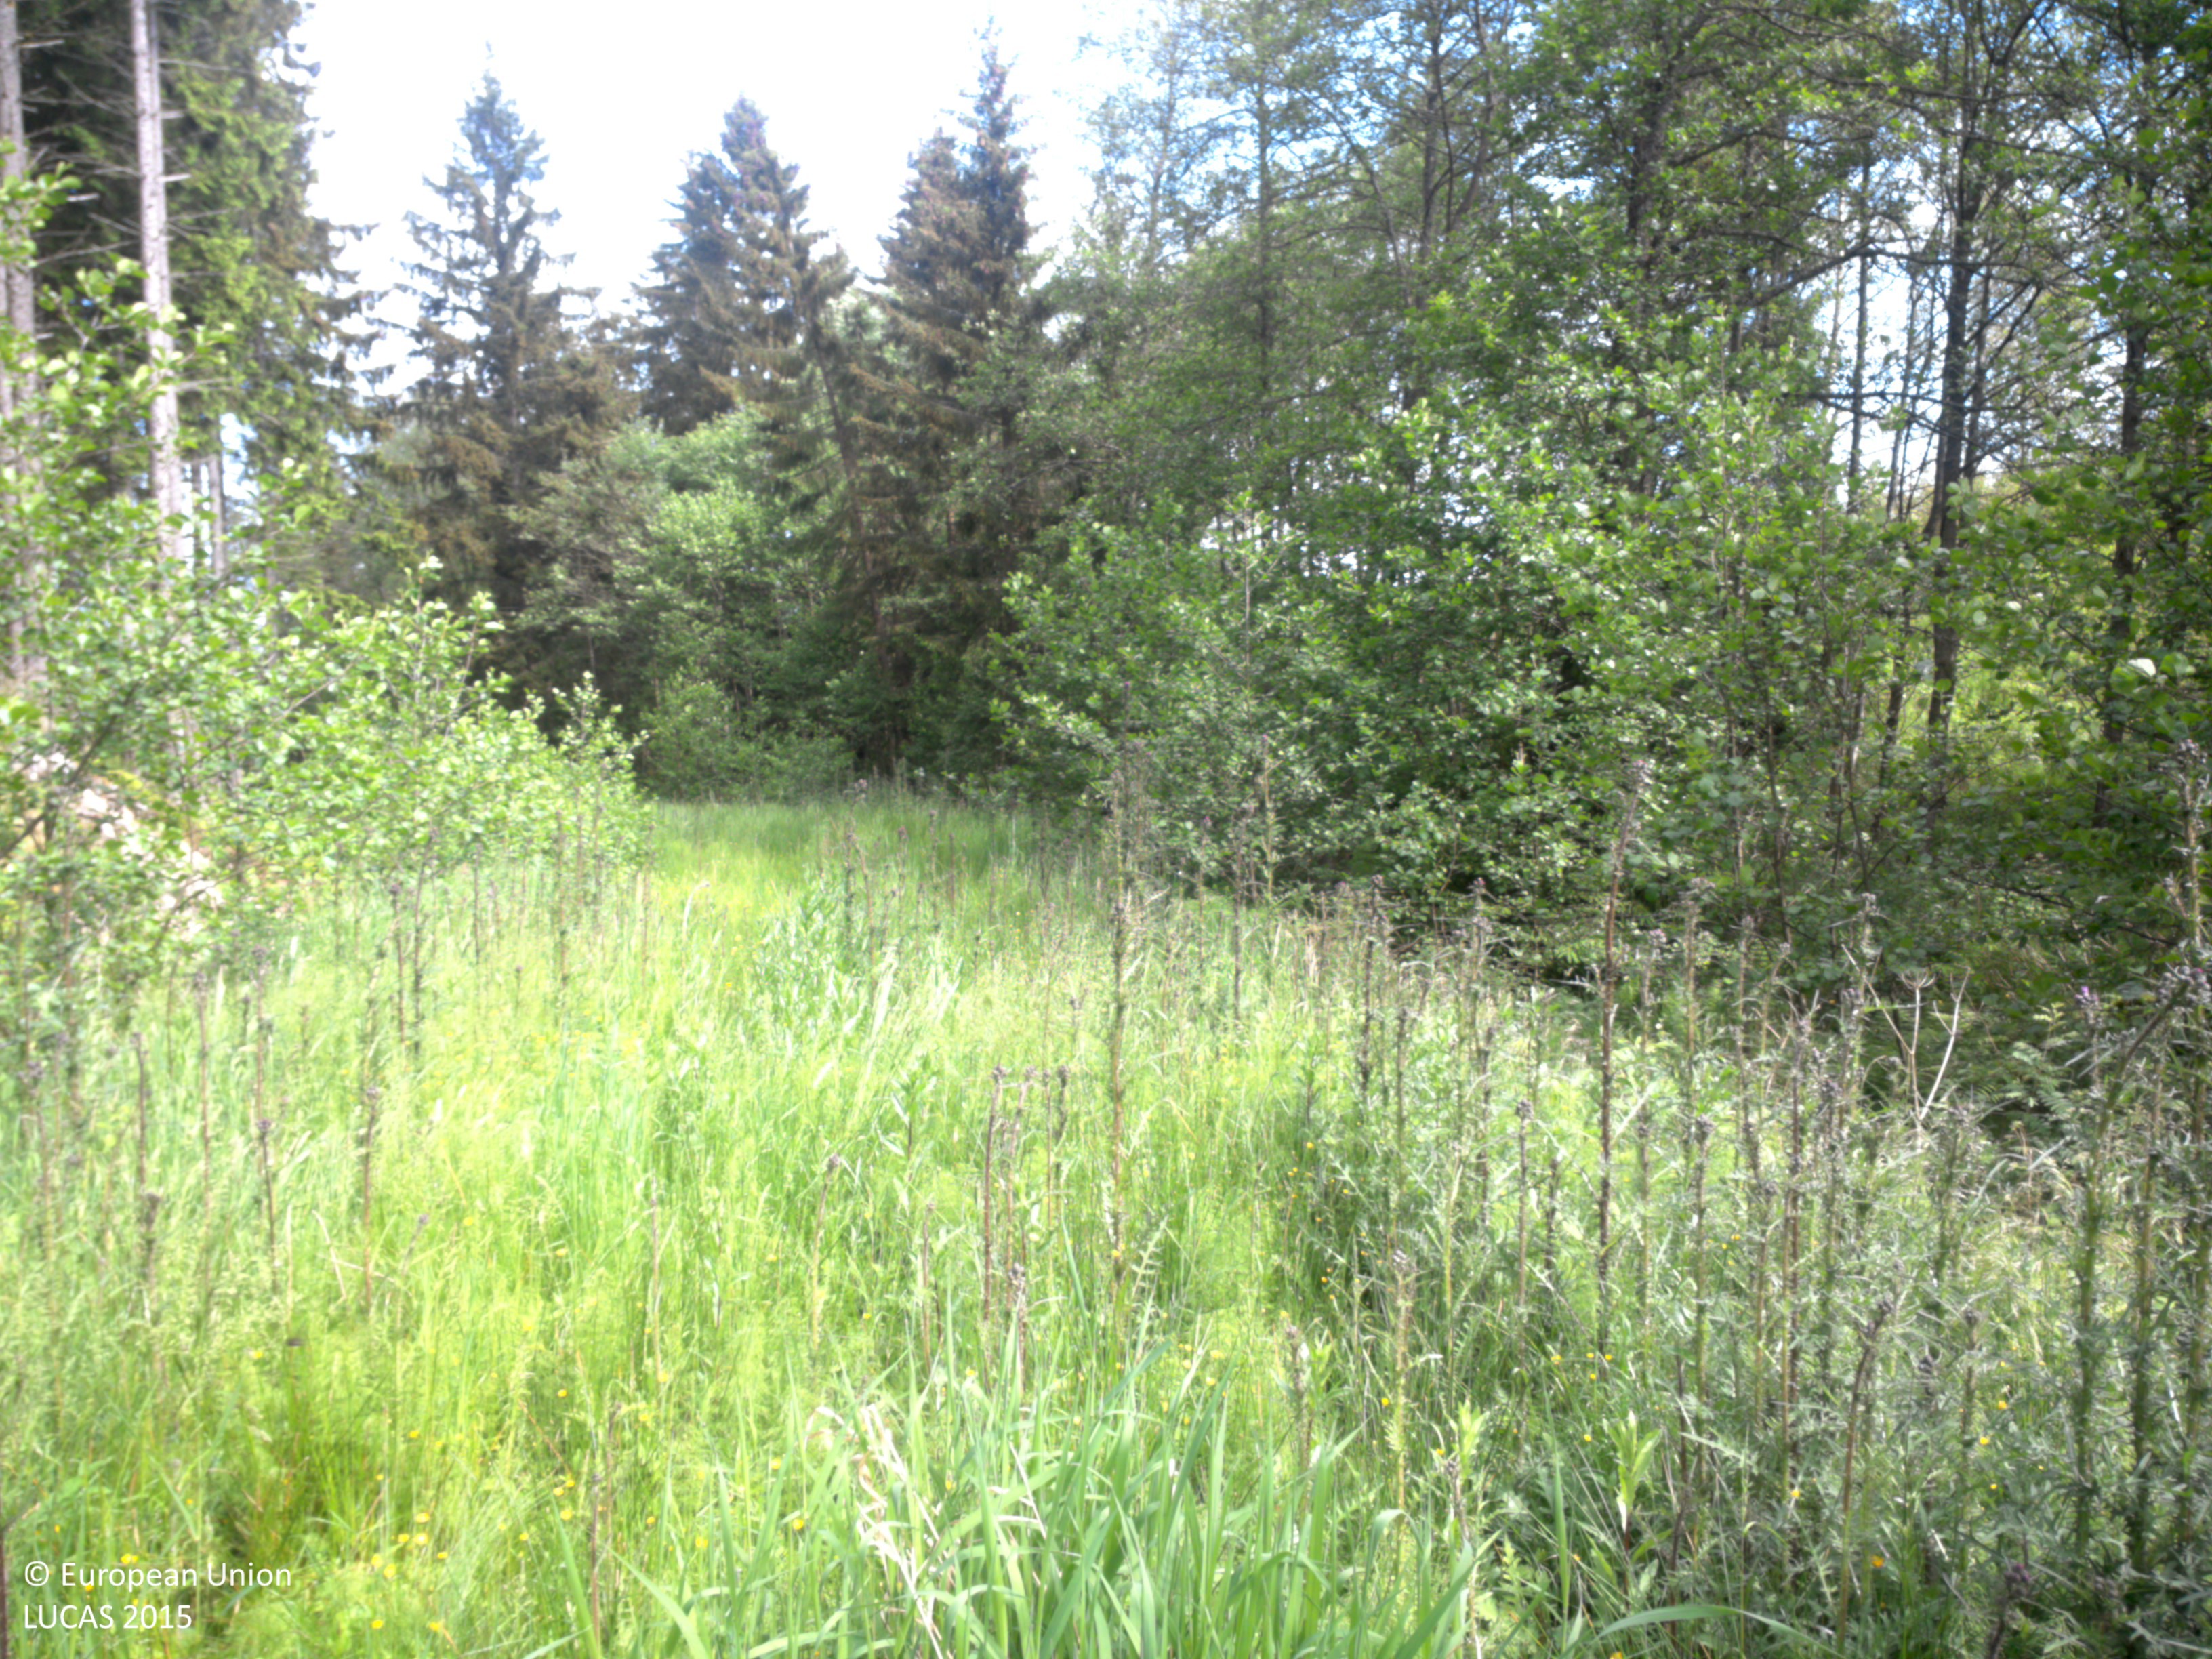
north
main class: Grassland
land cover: Grassland without tree/shrub cover
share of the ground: > 75 %
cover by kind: herbaceous plants 100 %
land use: Abandoned areas
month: June
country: SE
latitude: 58.6965
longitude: 11.5323
